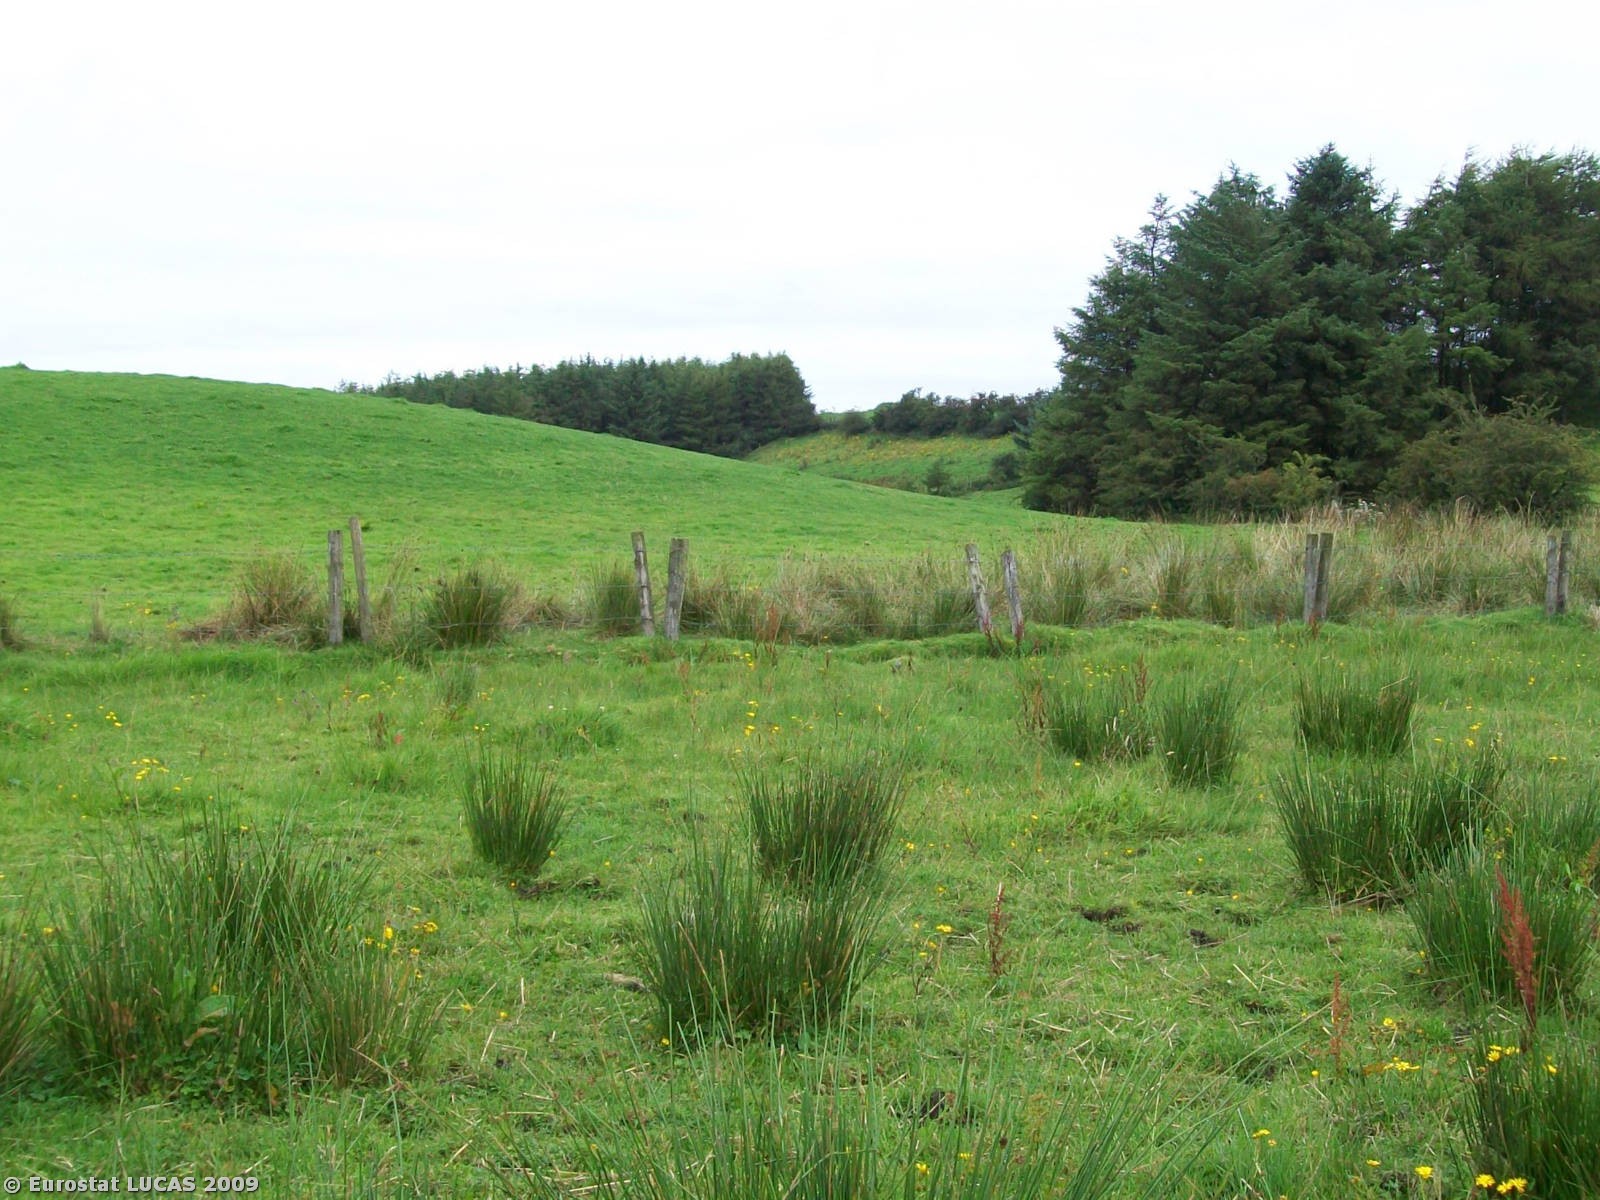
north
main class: Grassland
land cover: Grassland without tree/shrub cover
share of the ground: > 75 %
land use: Agriculture (excluding fallow land and kitchen gardens)
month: August
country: GB
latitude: 54.2152
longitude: -6.7084
